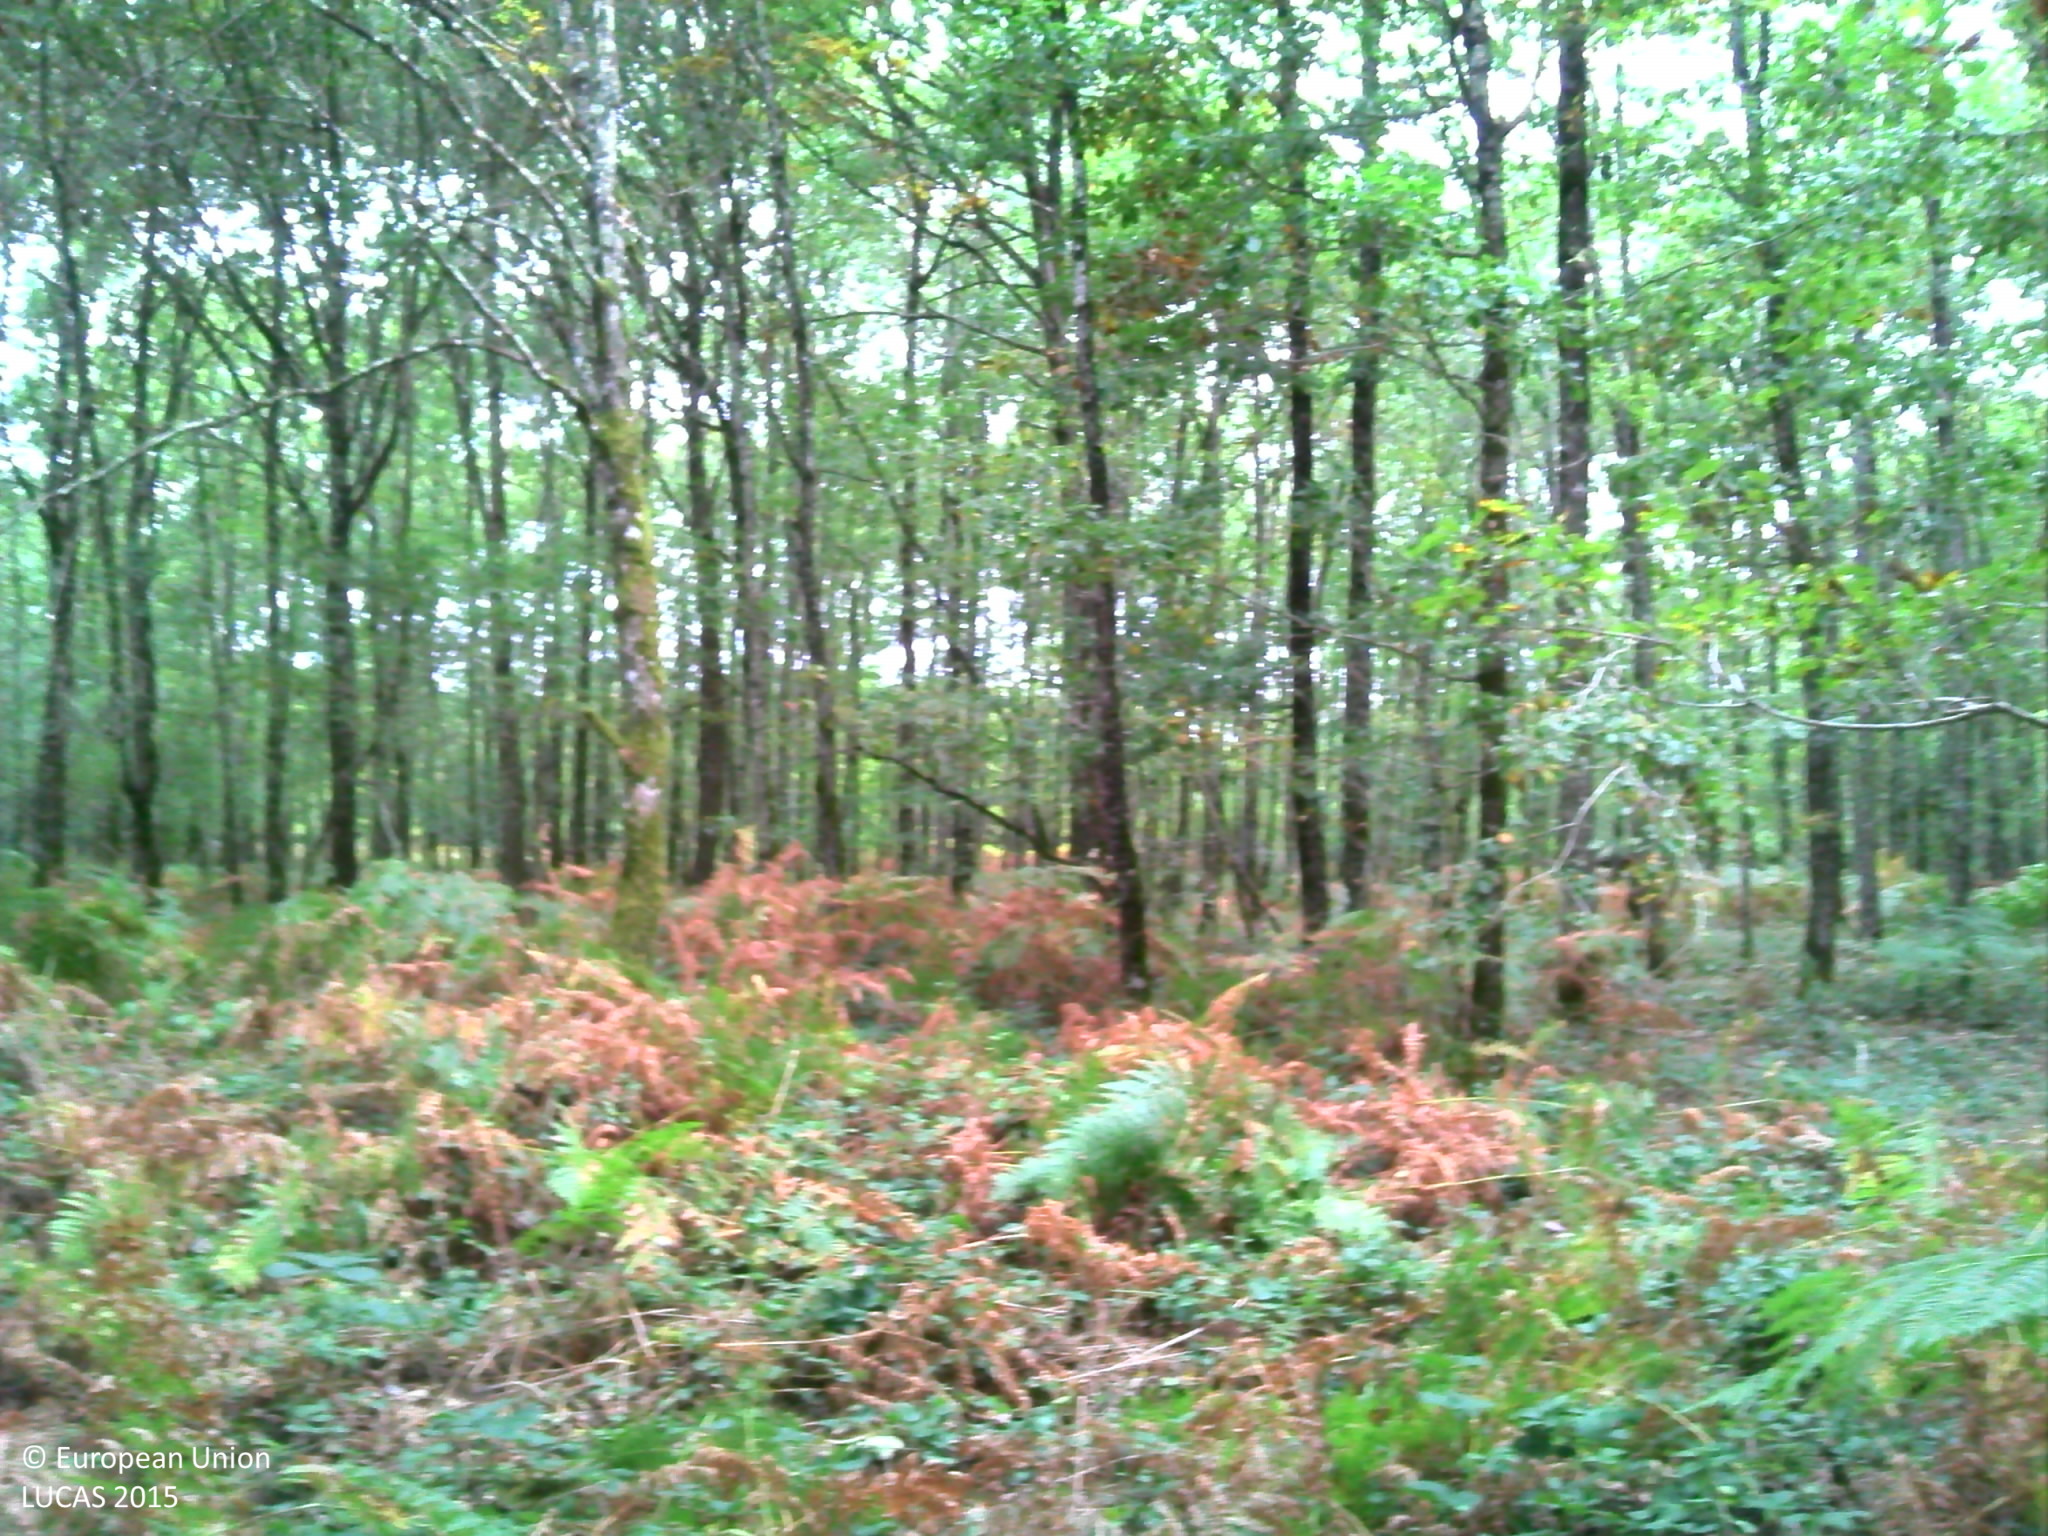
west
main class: Woodland
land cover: Broadleaved woodland
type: mesophytic deciduous forest
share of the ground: > 75 %
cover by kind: broadleaved forest trees 100 %
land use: Forestry
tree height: > 5 m
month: August
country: FR
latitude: 47.2387
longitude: 2.1575
